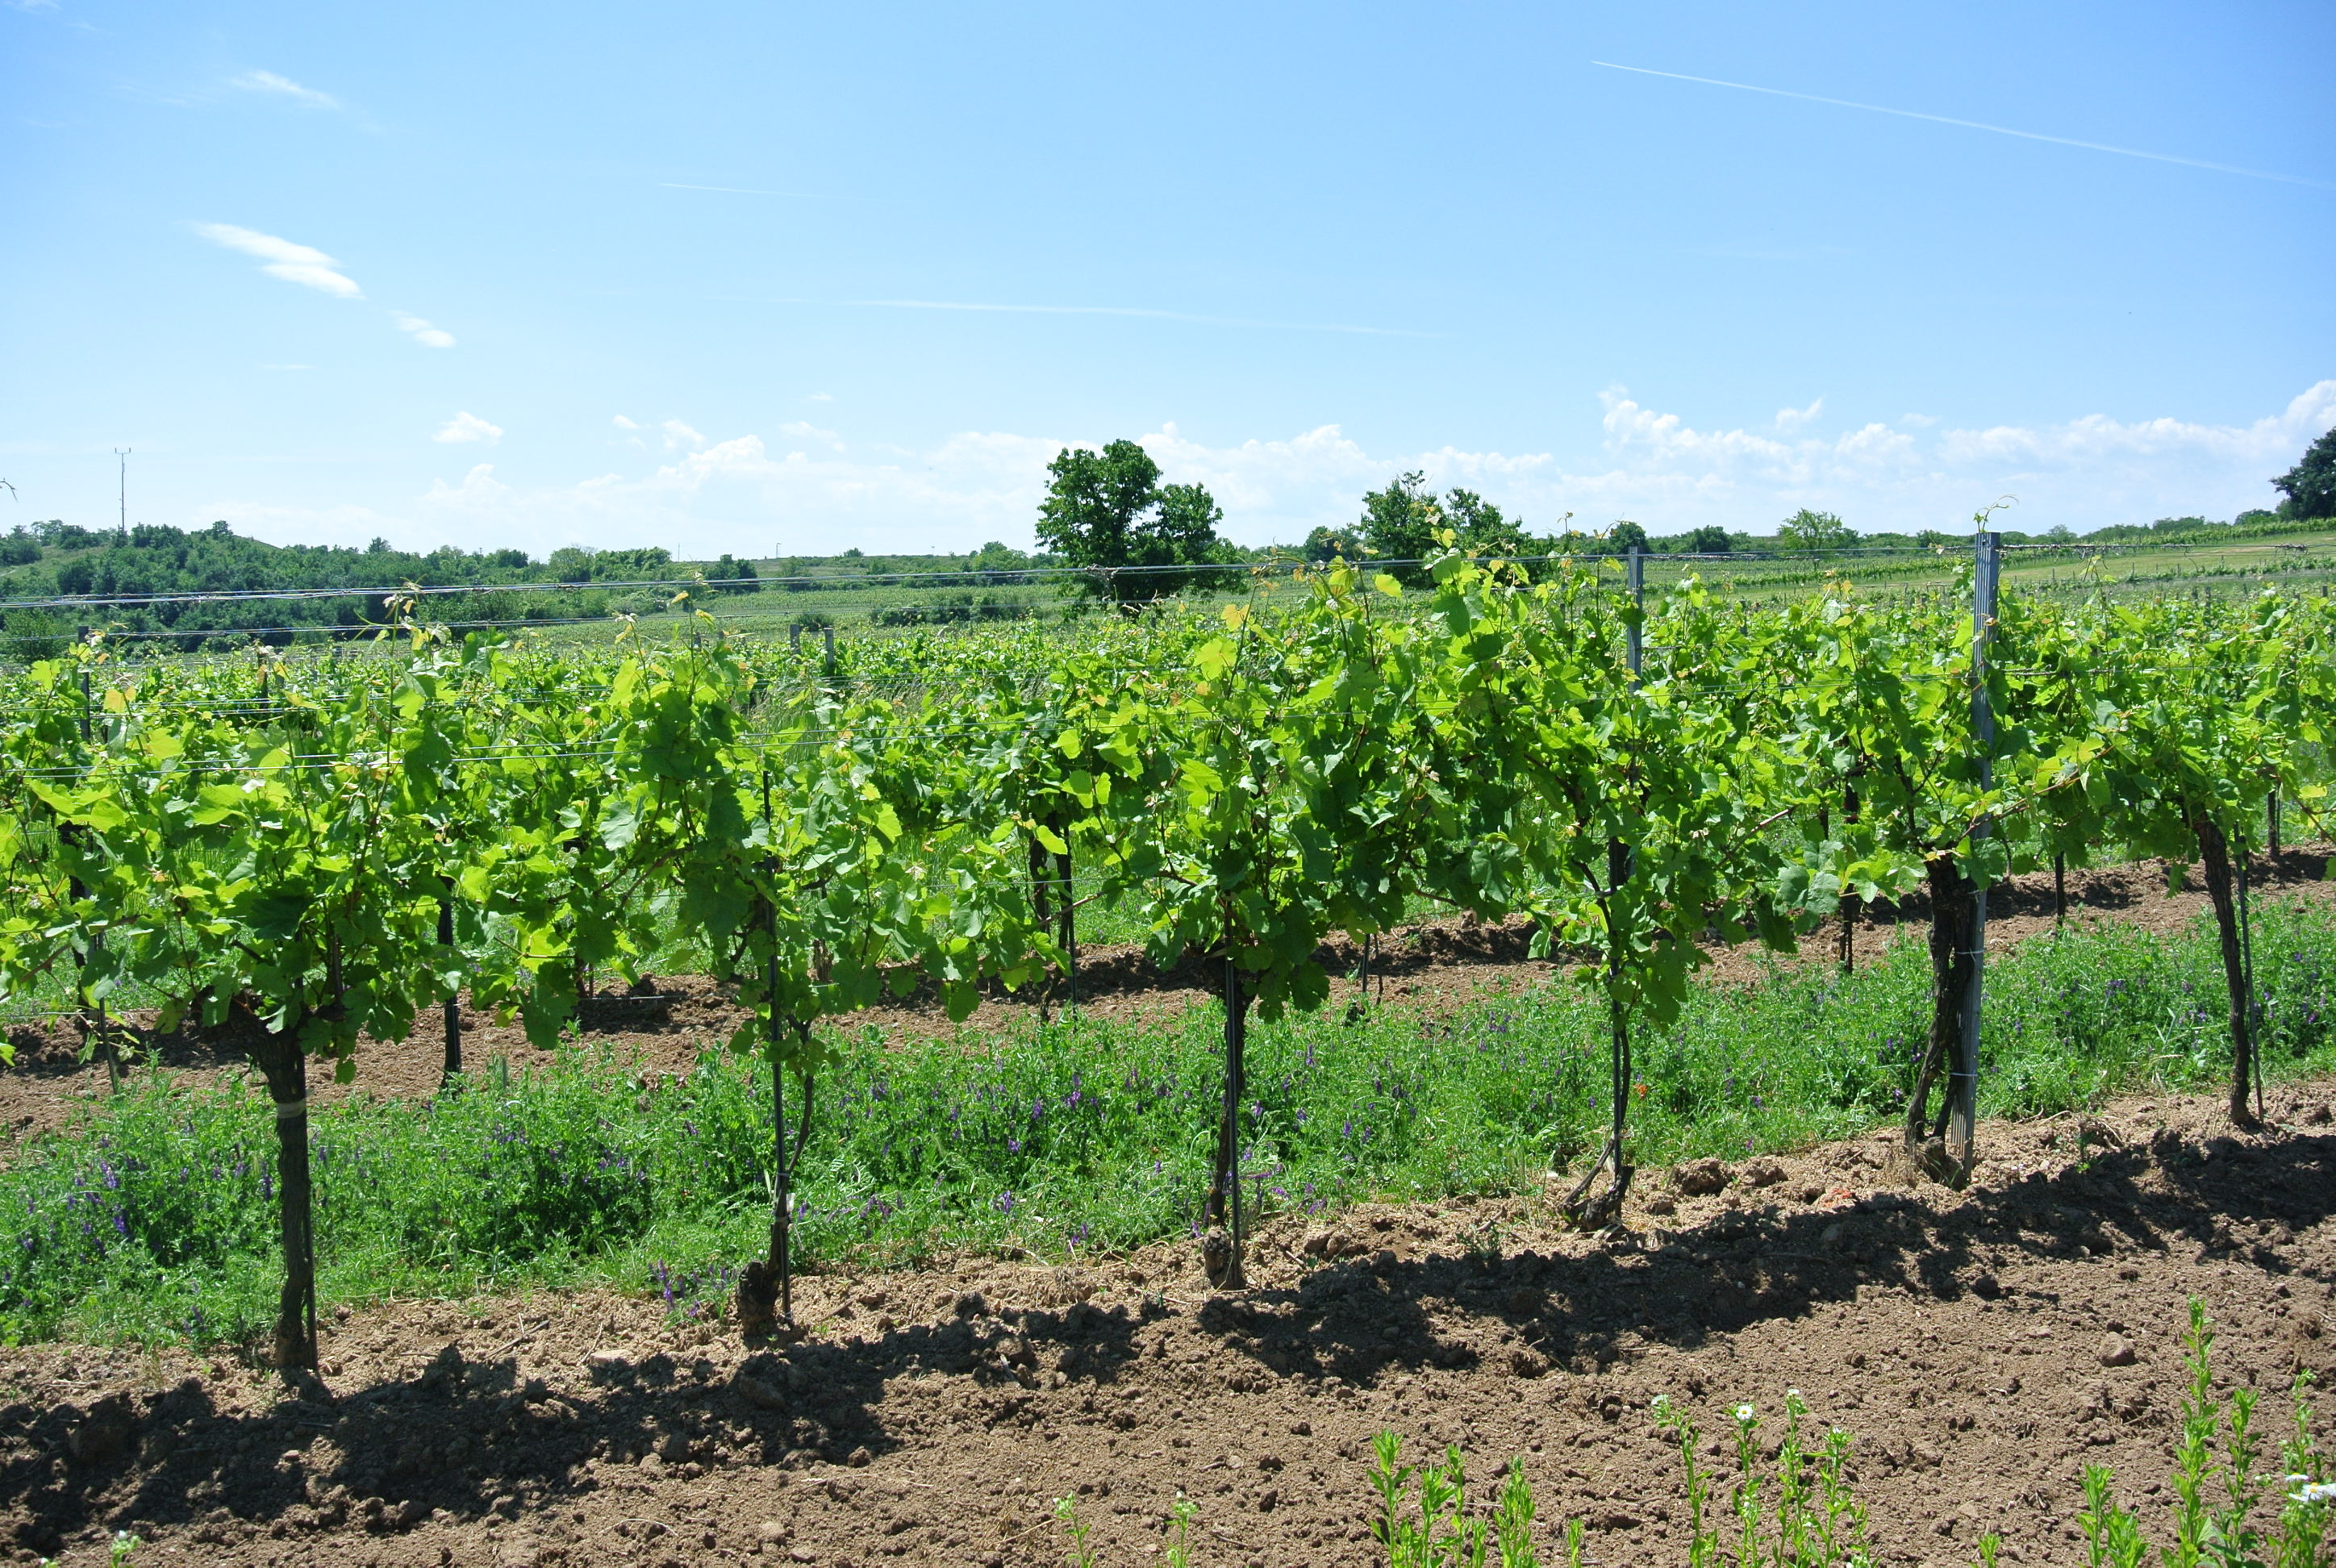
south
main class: Cropland
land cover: Temporary grasslands
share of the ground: > 75 %
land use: Agriculture (excluding fallow land and kitchen gardens)
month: June
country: AT
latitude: 47.8066
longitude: 16.6415
